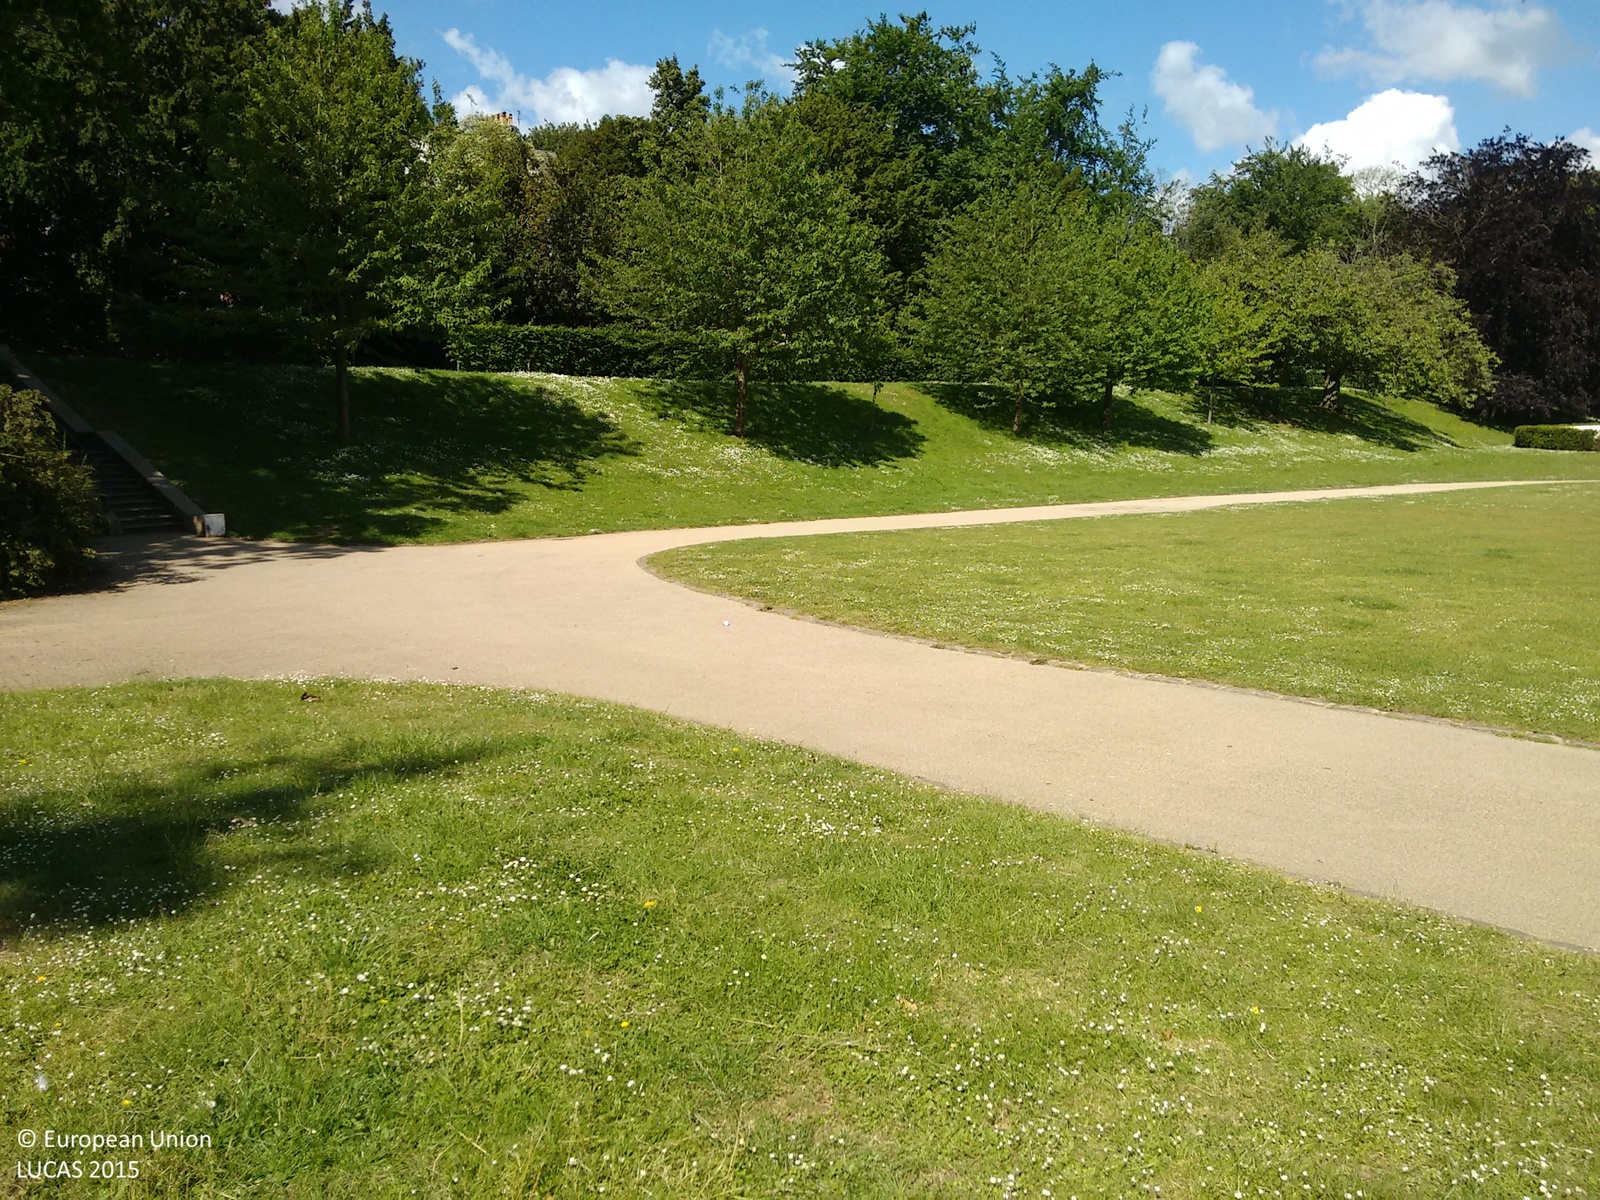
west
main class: Grassland
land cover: Grassland without tree/shrub cover
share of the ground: > 75 %
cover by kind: herbaceous plants 100 %
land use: Amenities, museums, leisure
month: June
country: GB
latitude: 50.8618
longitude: 0.5819
